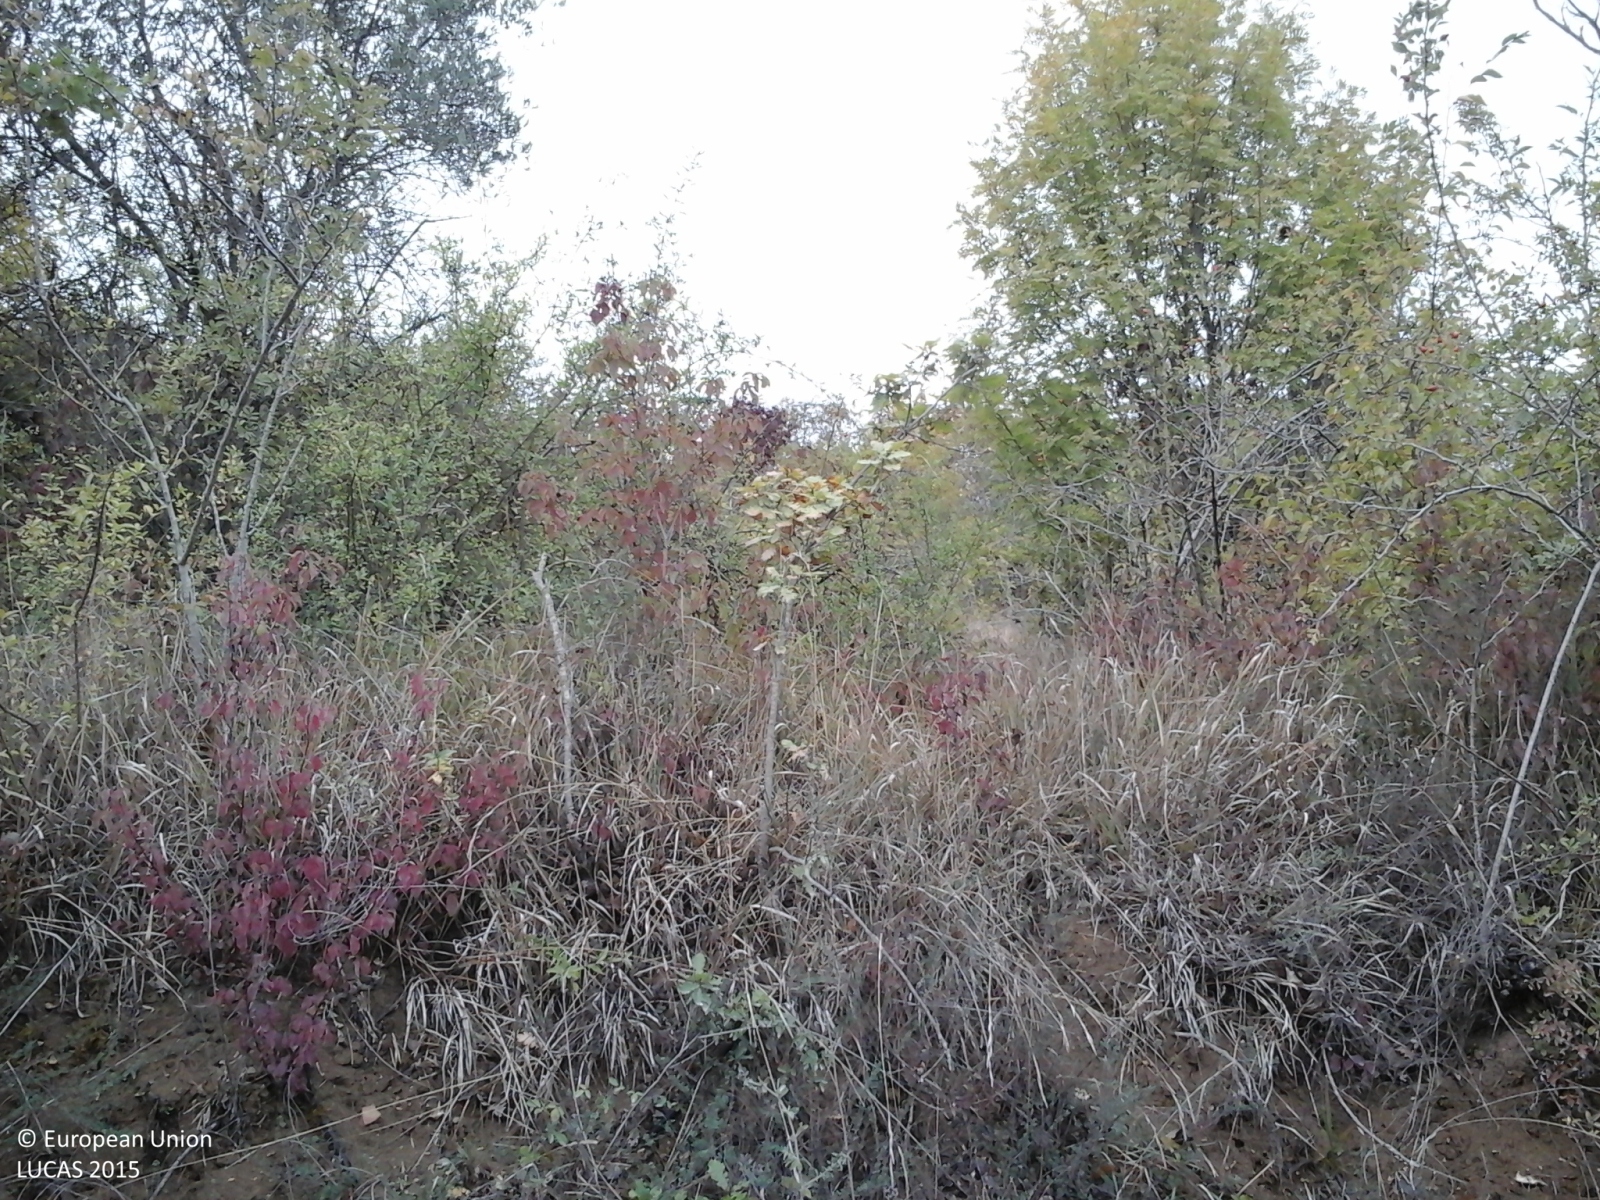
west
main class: Woodland
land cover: Broadleaved woodland
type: thermophilous deciduous forest
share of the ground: > 75 %
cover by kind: broadleaved forest trees 90 %, shrubs 10 %
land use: Forestry
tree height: > 5 m
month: October
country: IT
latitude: 43.1677
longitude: 12.3917
